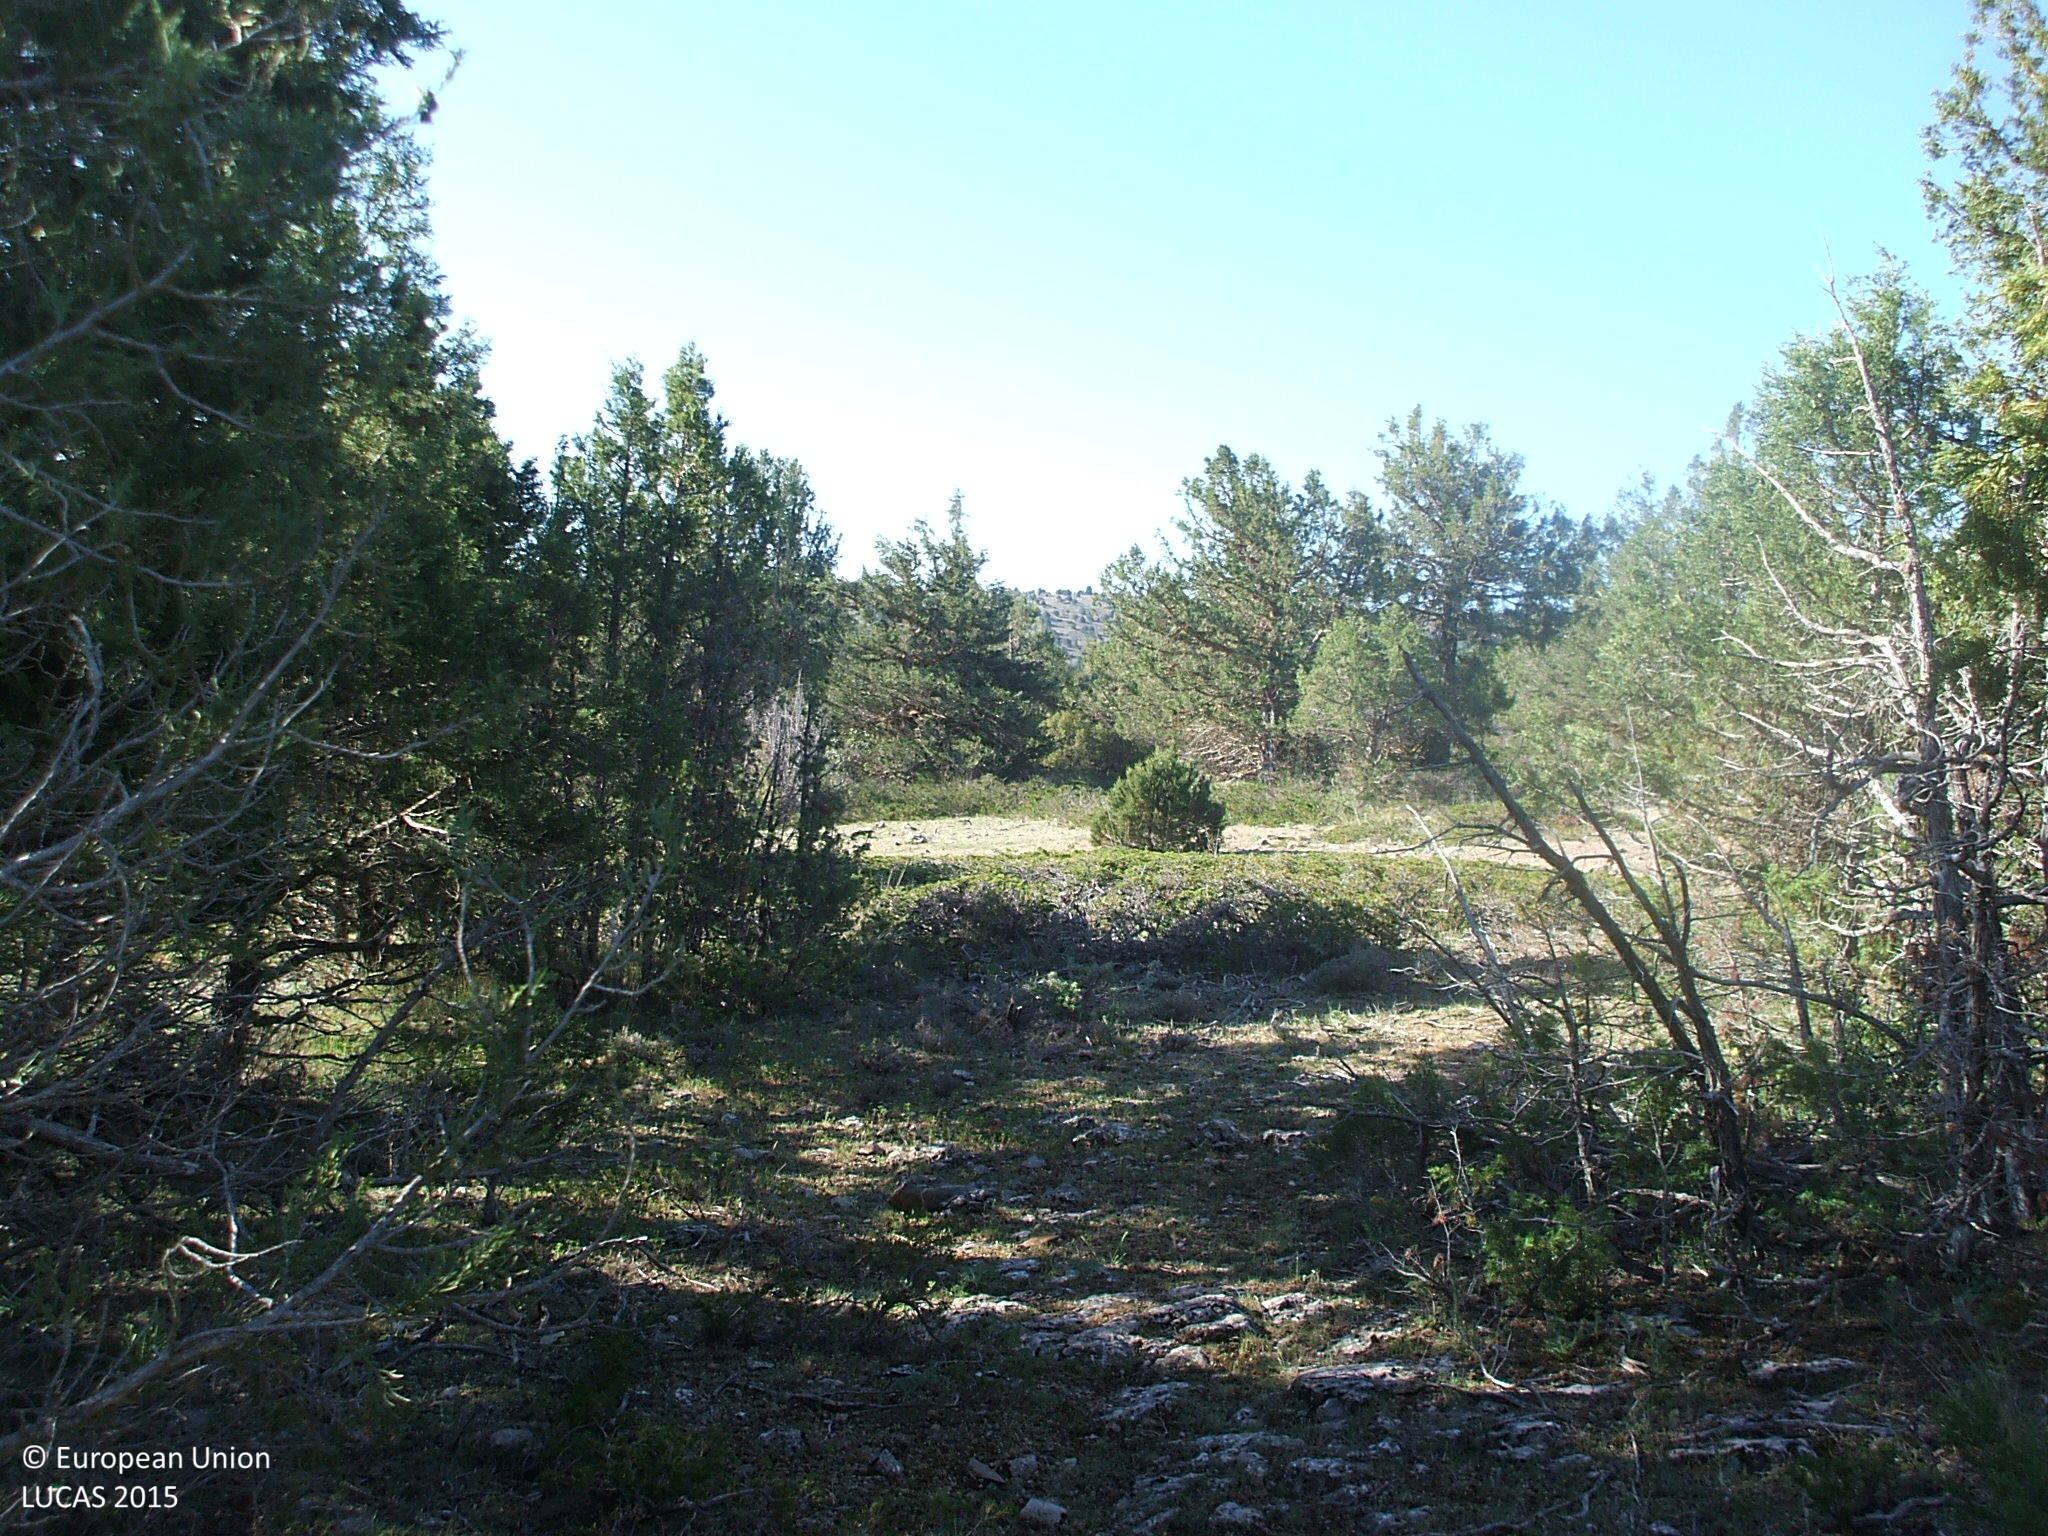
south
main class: Woodland
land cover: Other coniferous woodland
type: coniferous forest of the mediterranean region
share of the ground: 50 - 75 %
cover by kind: coniferous forest trees 60 %, herbaceous plants 40 %
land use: Semi-natural and natural areas not in use
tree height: > 5 m
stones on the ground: > 50 %
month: May
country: ES
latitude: 40.1440
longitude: -0.9591
